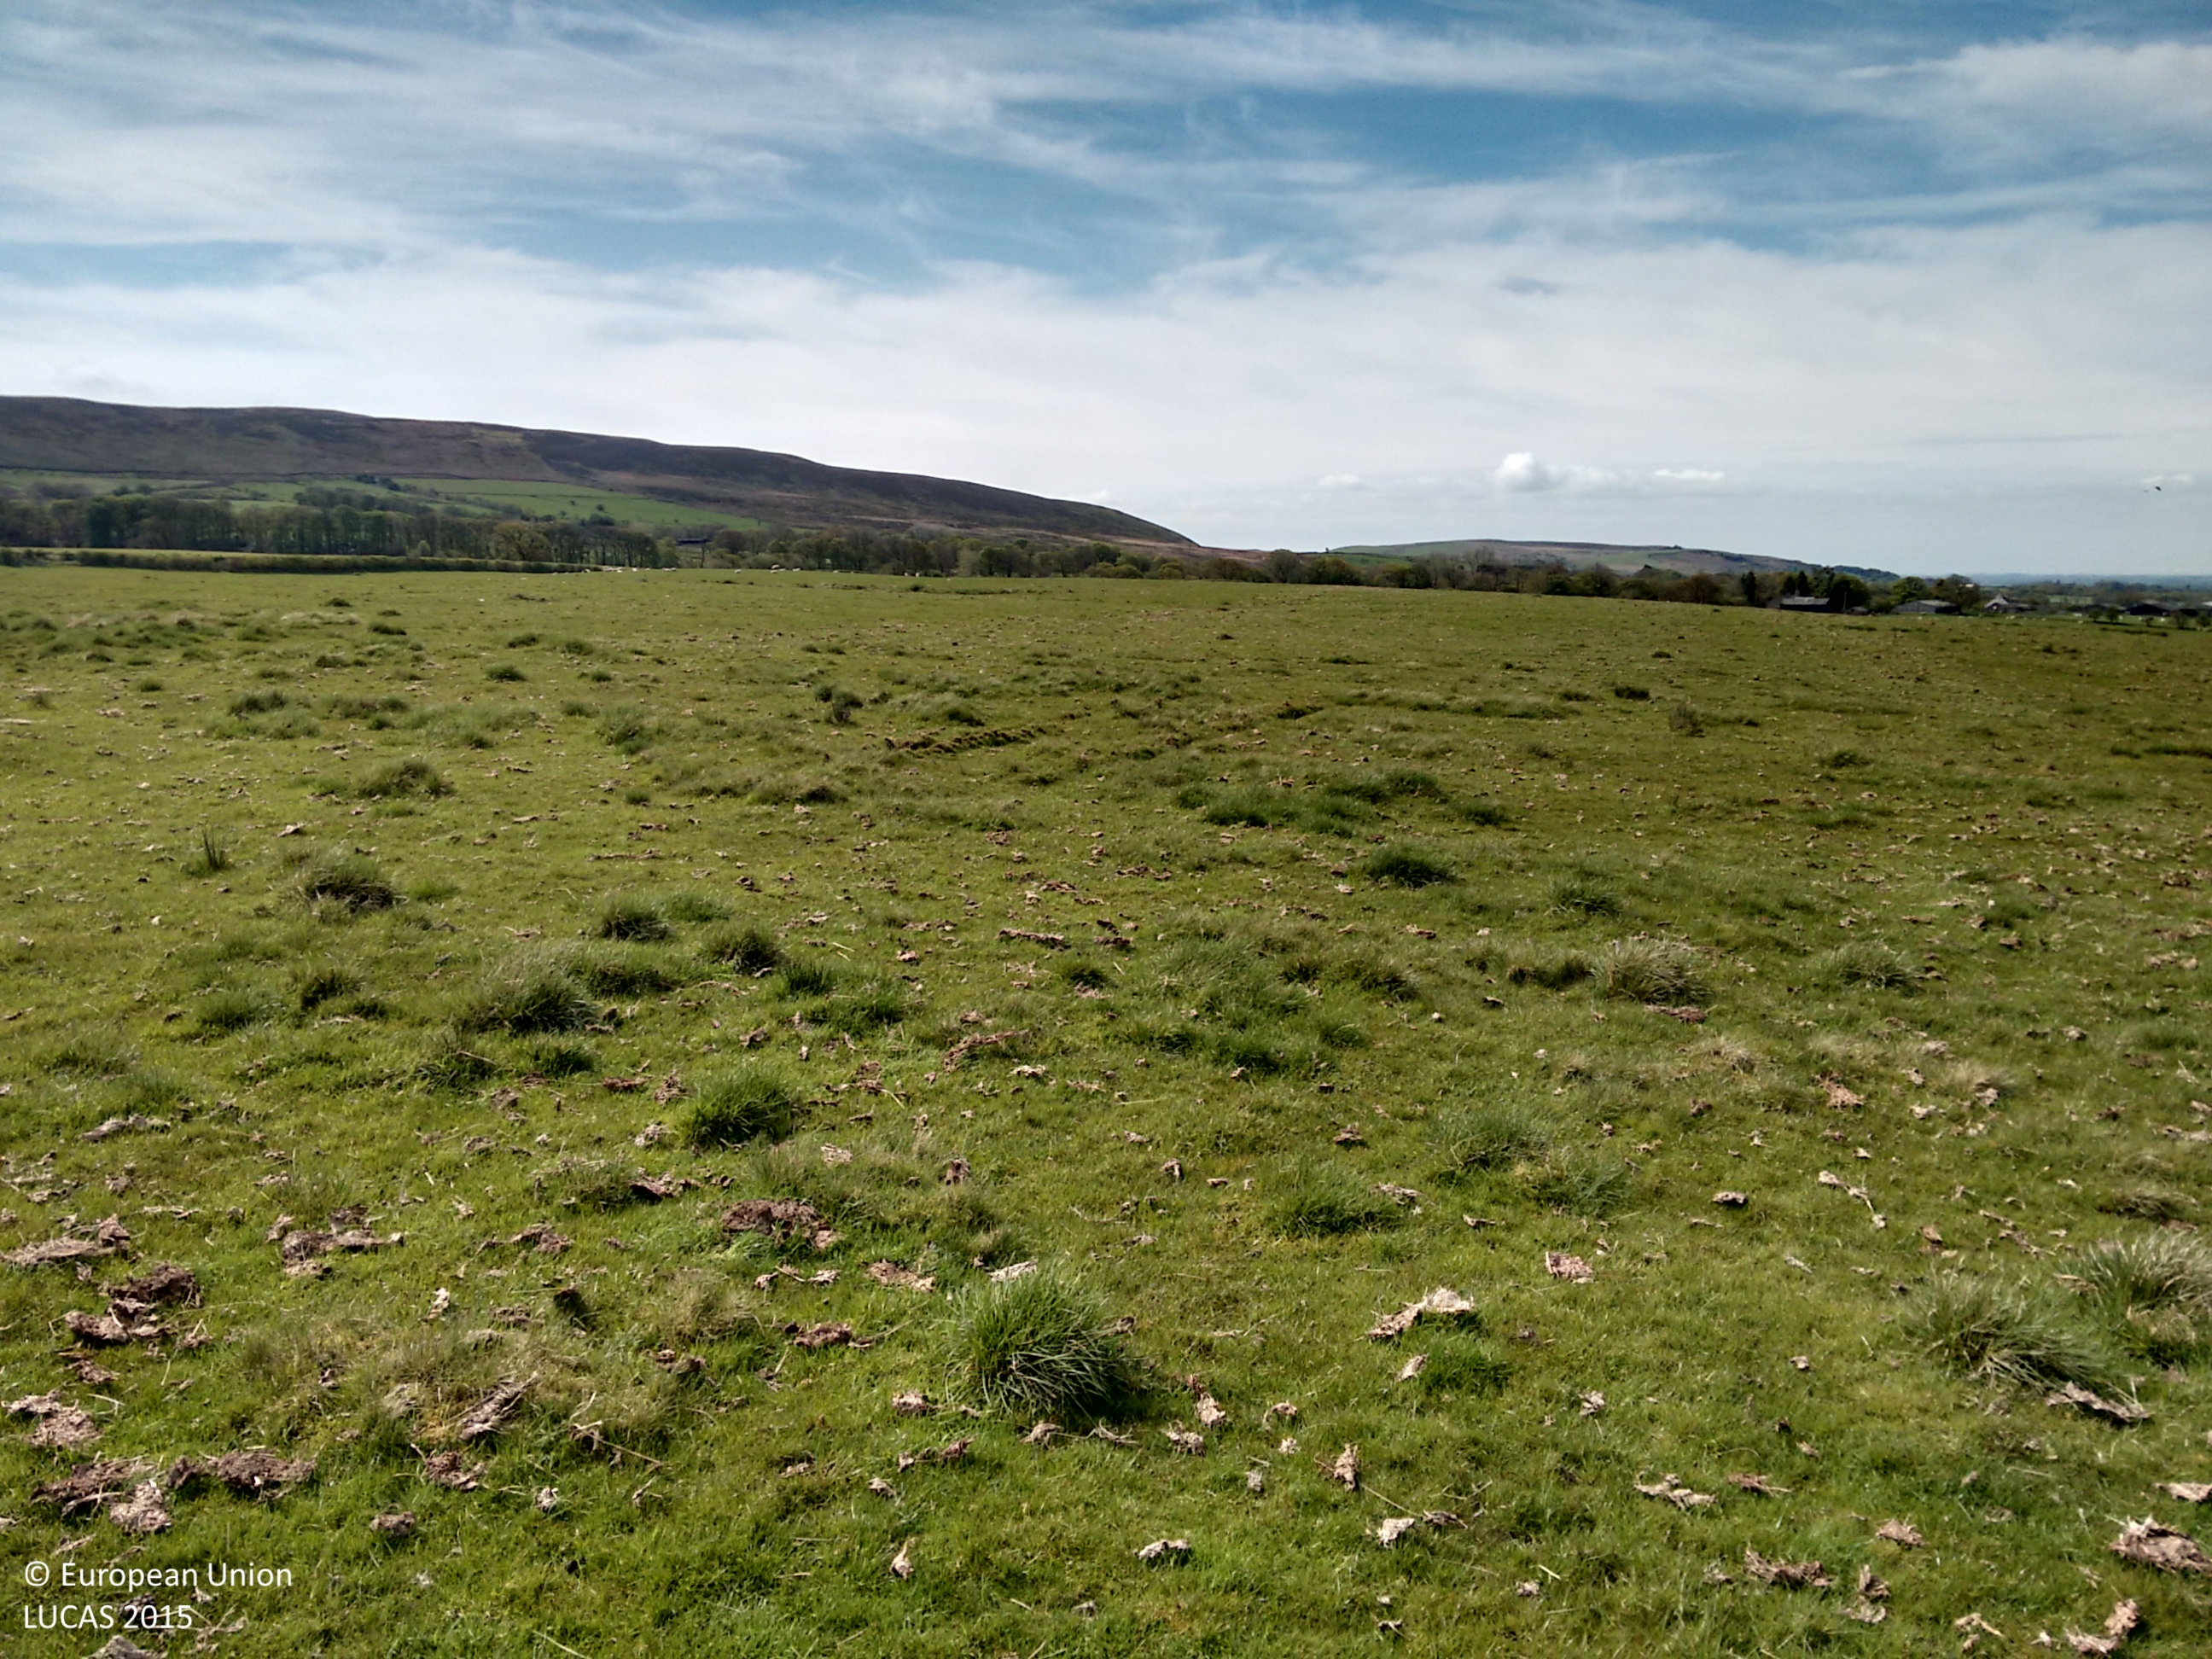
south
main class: Grassland
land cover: Grassland without tree/shrub cover
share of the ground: > 75 %
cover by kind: herbaceous plants 100 %
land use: Agriculture (excluding fallow land and kitchen gardens)
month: May
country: GB
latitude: 53.9677
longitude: -2.7054
